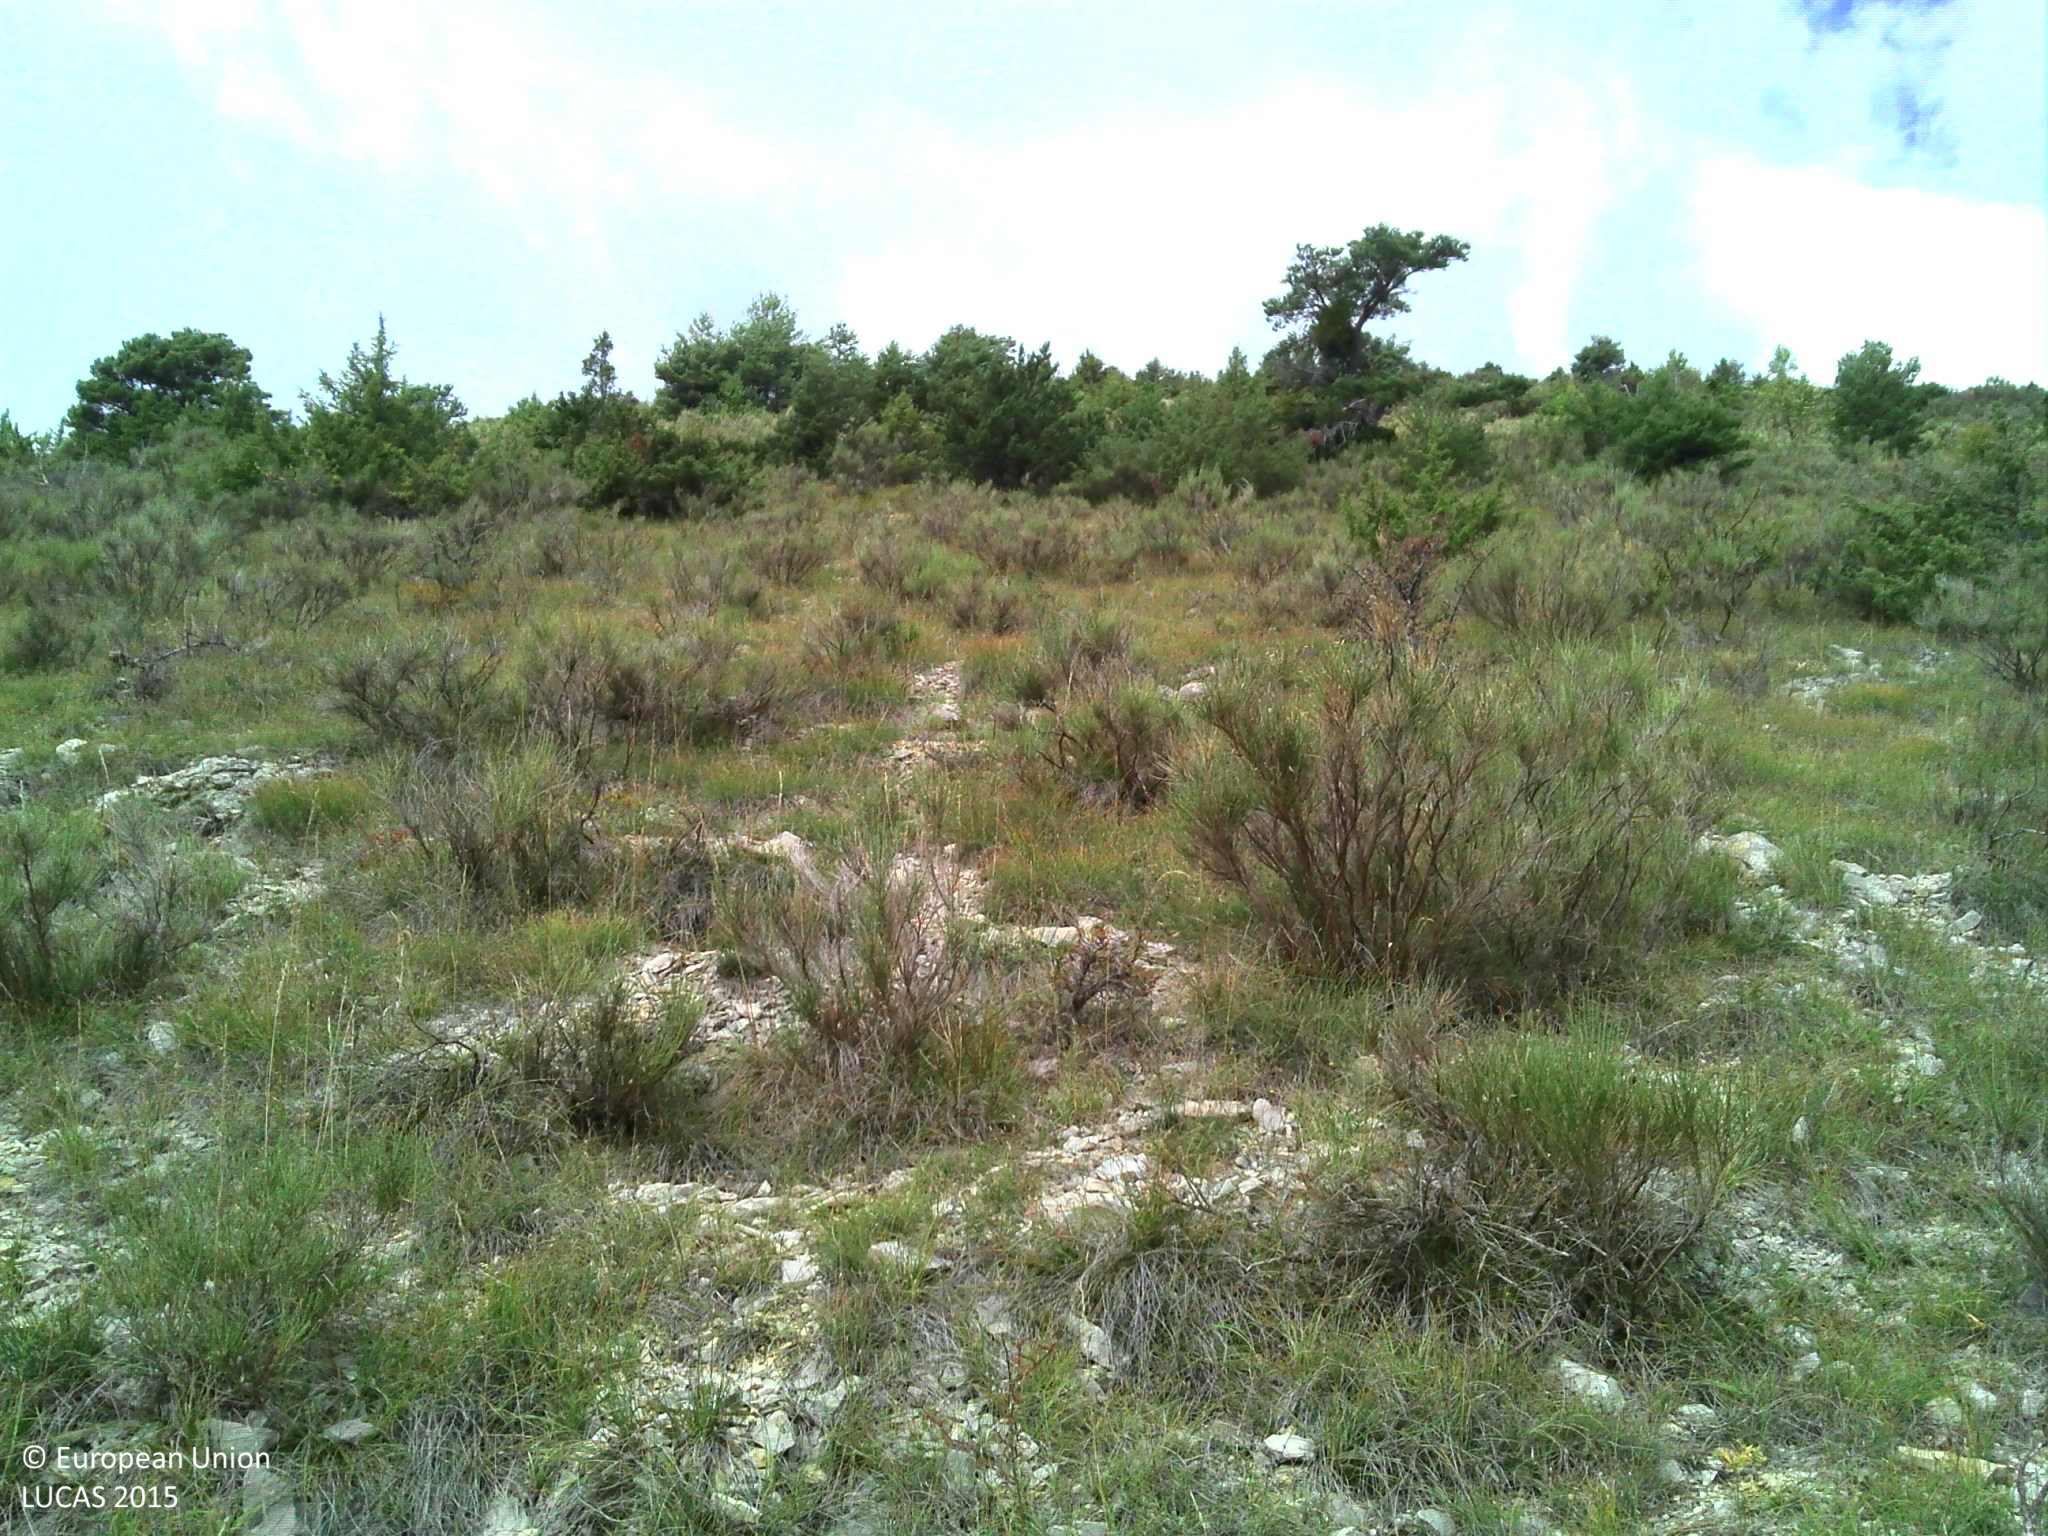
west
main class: Shrubland
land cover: Shrubland with sparse tree cover
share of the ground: 25 - 50 %
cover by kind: shrubs 55 %, herbaceous plants 20 %, consolidated bare surface 20 %, broadleaved forest trees 5 %
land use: Semi-natural and natural areas not in use
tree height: > 5 m
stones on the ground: 10 - 25 %
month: September
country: FR
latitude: 44.3975
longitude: 5.5000
